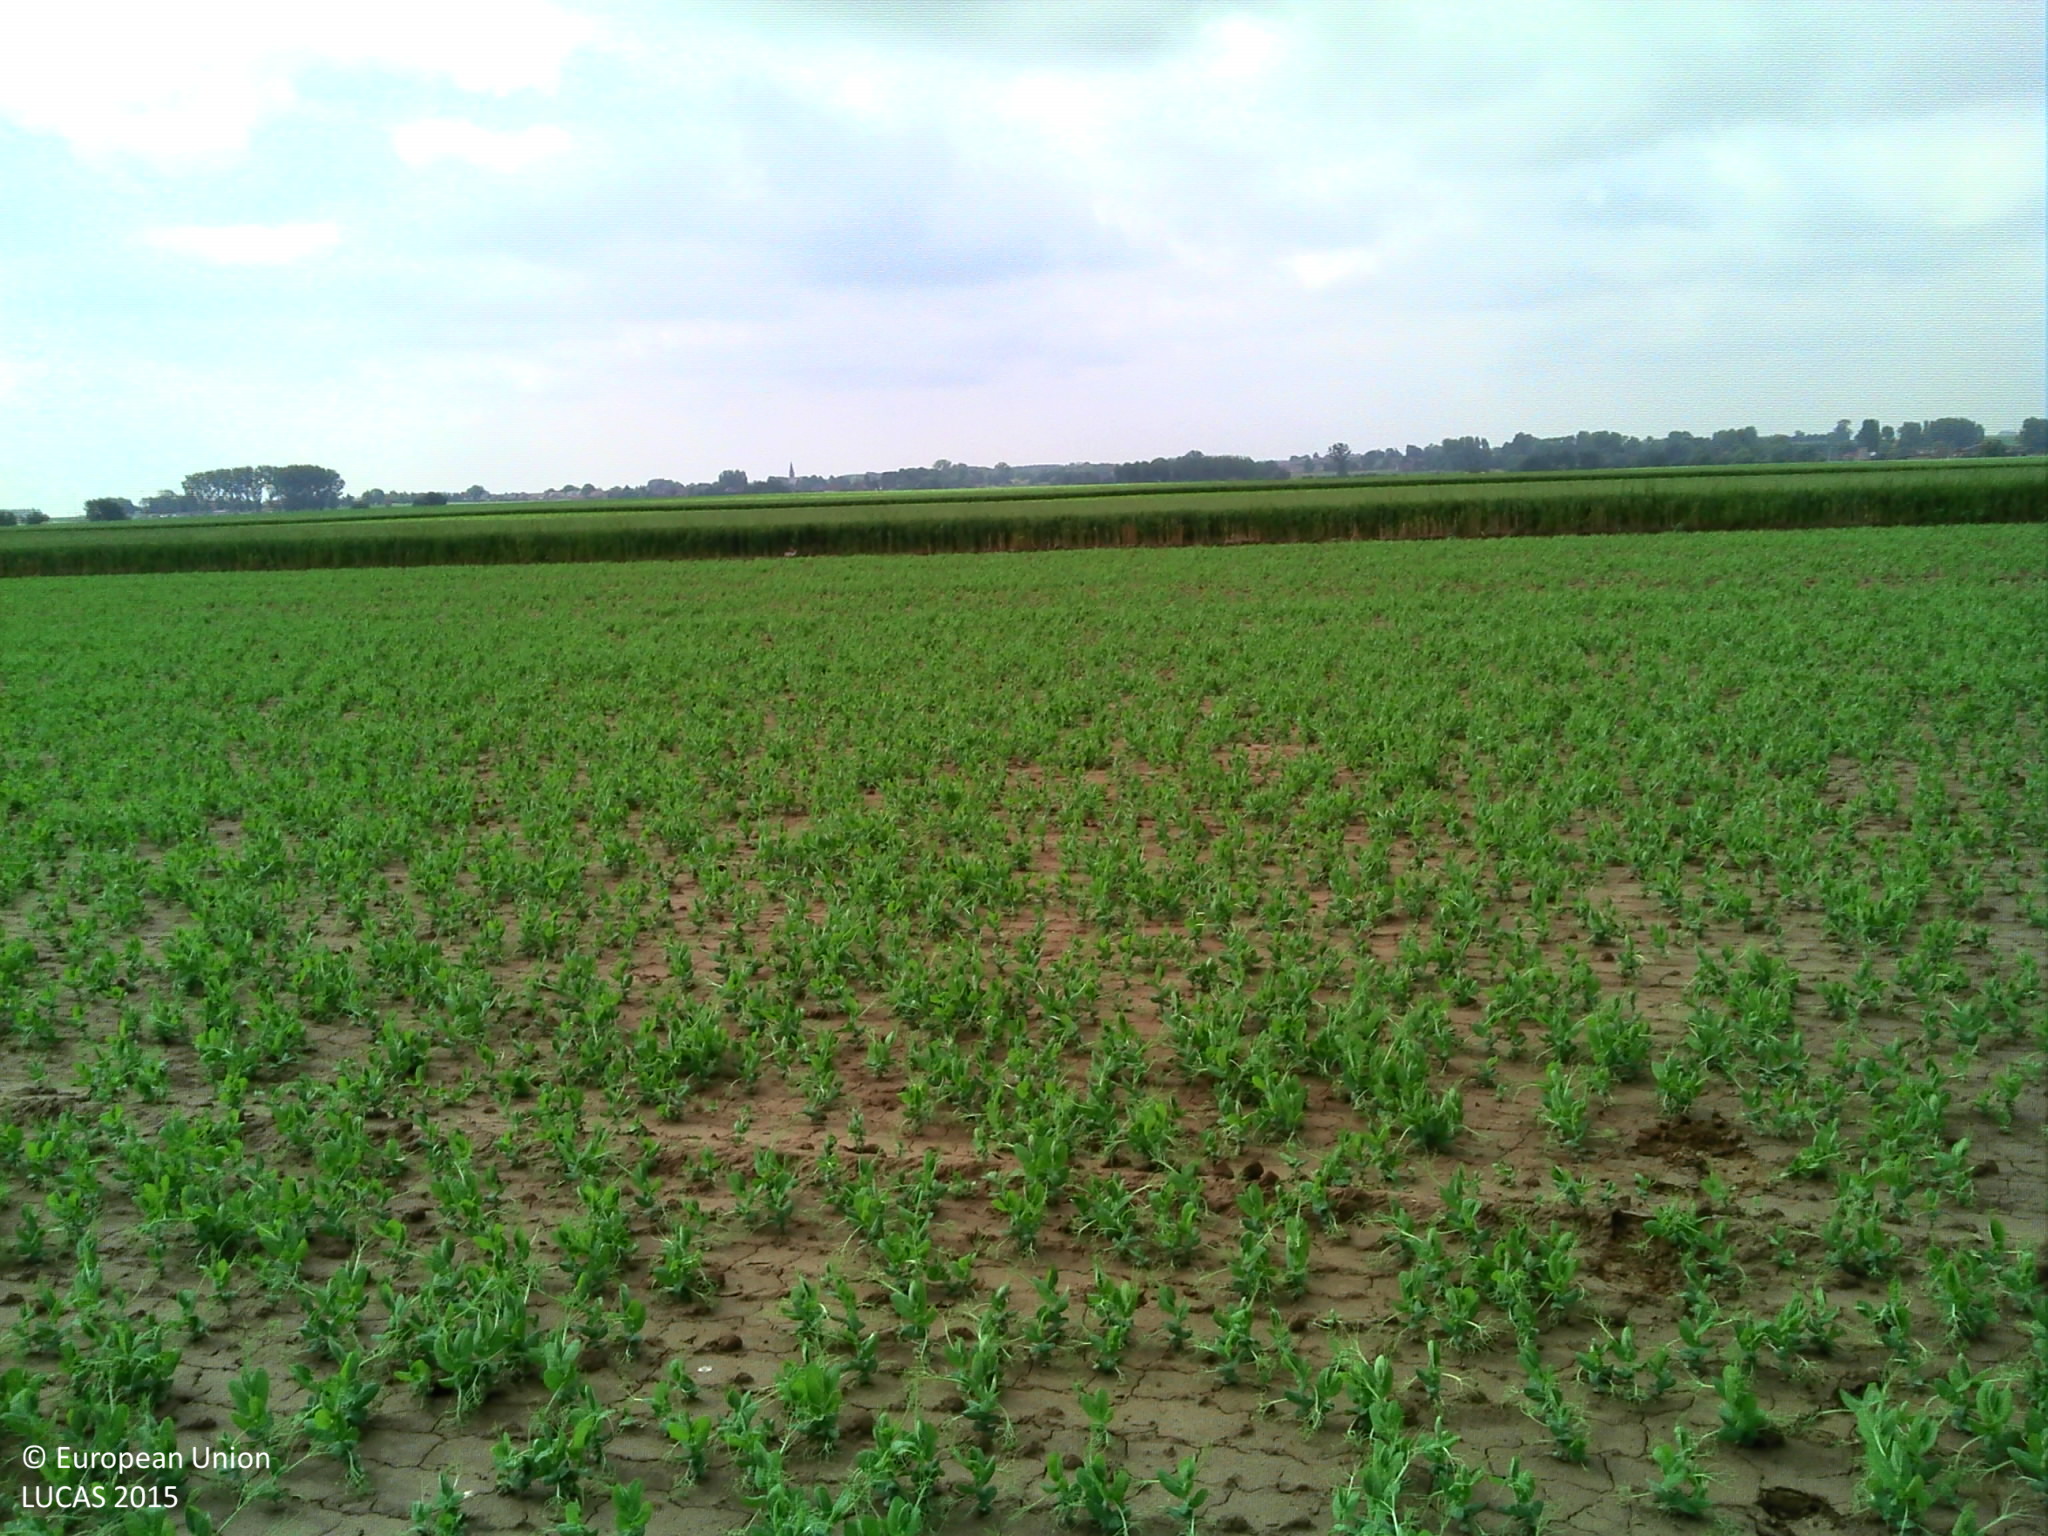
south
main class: Cropland
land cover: Dry pulses
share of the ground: 50 - 75 %
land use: Agriculture (excluding fallow land and kitchen gardens)
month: June
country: BE
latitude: 50.5743
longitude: 3.7945
